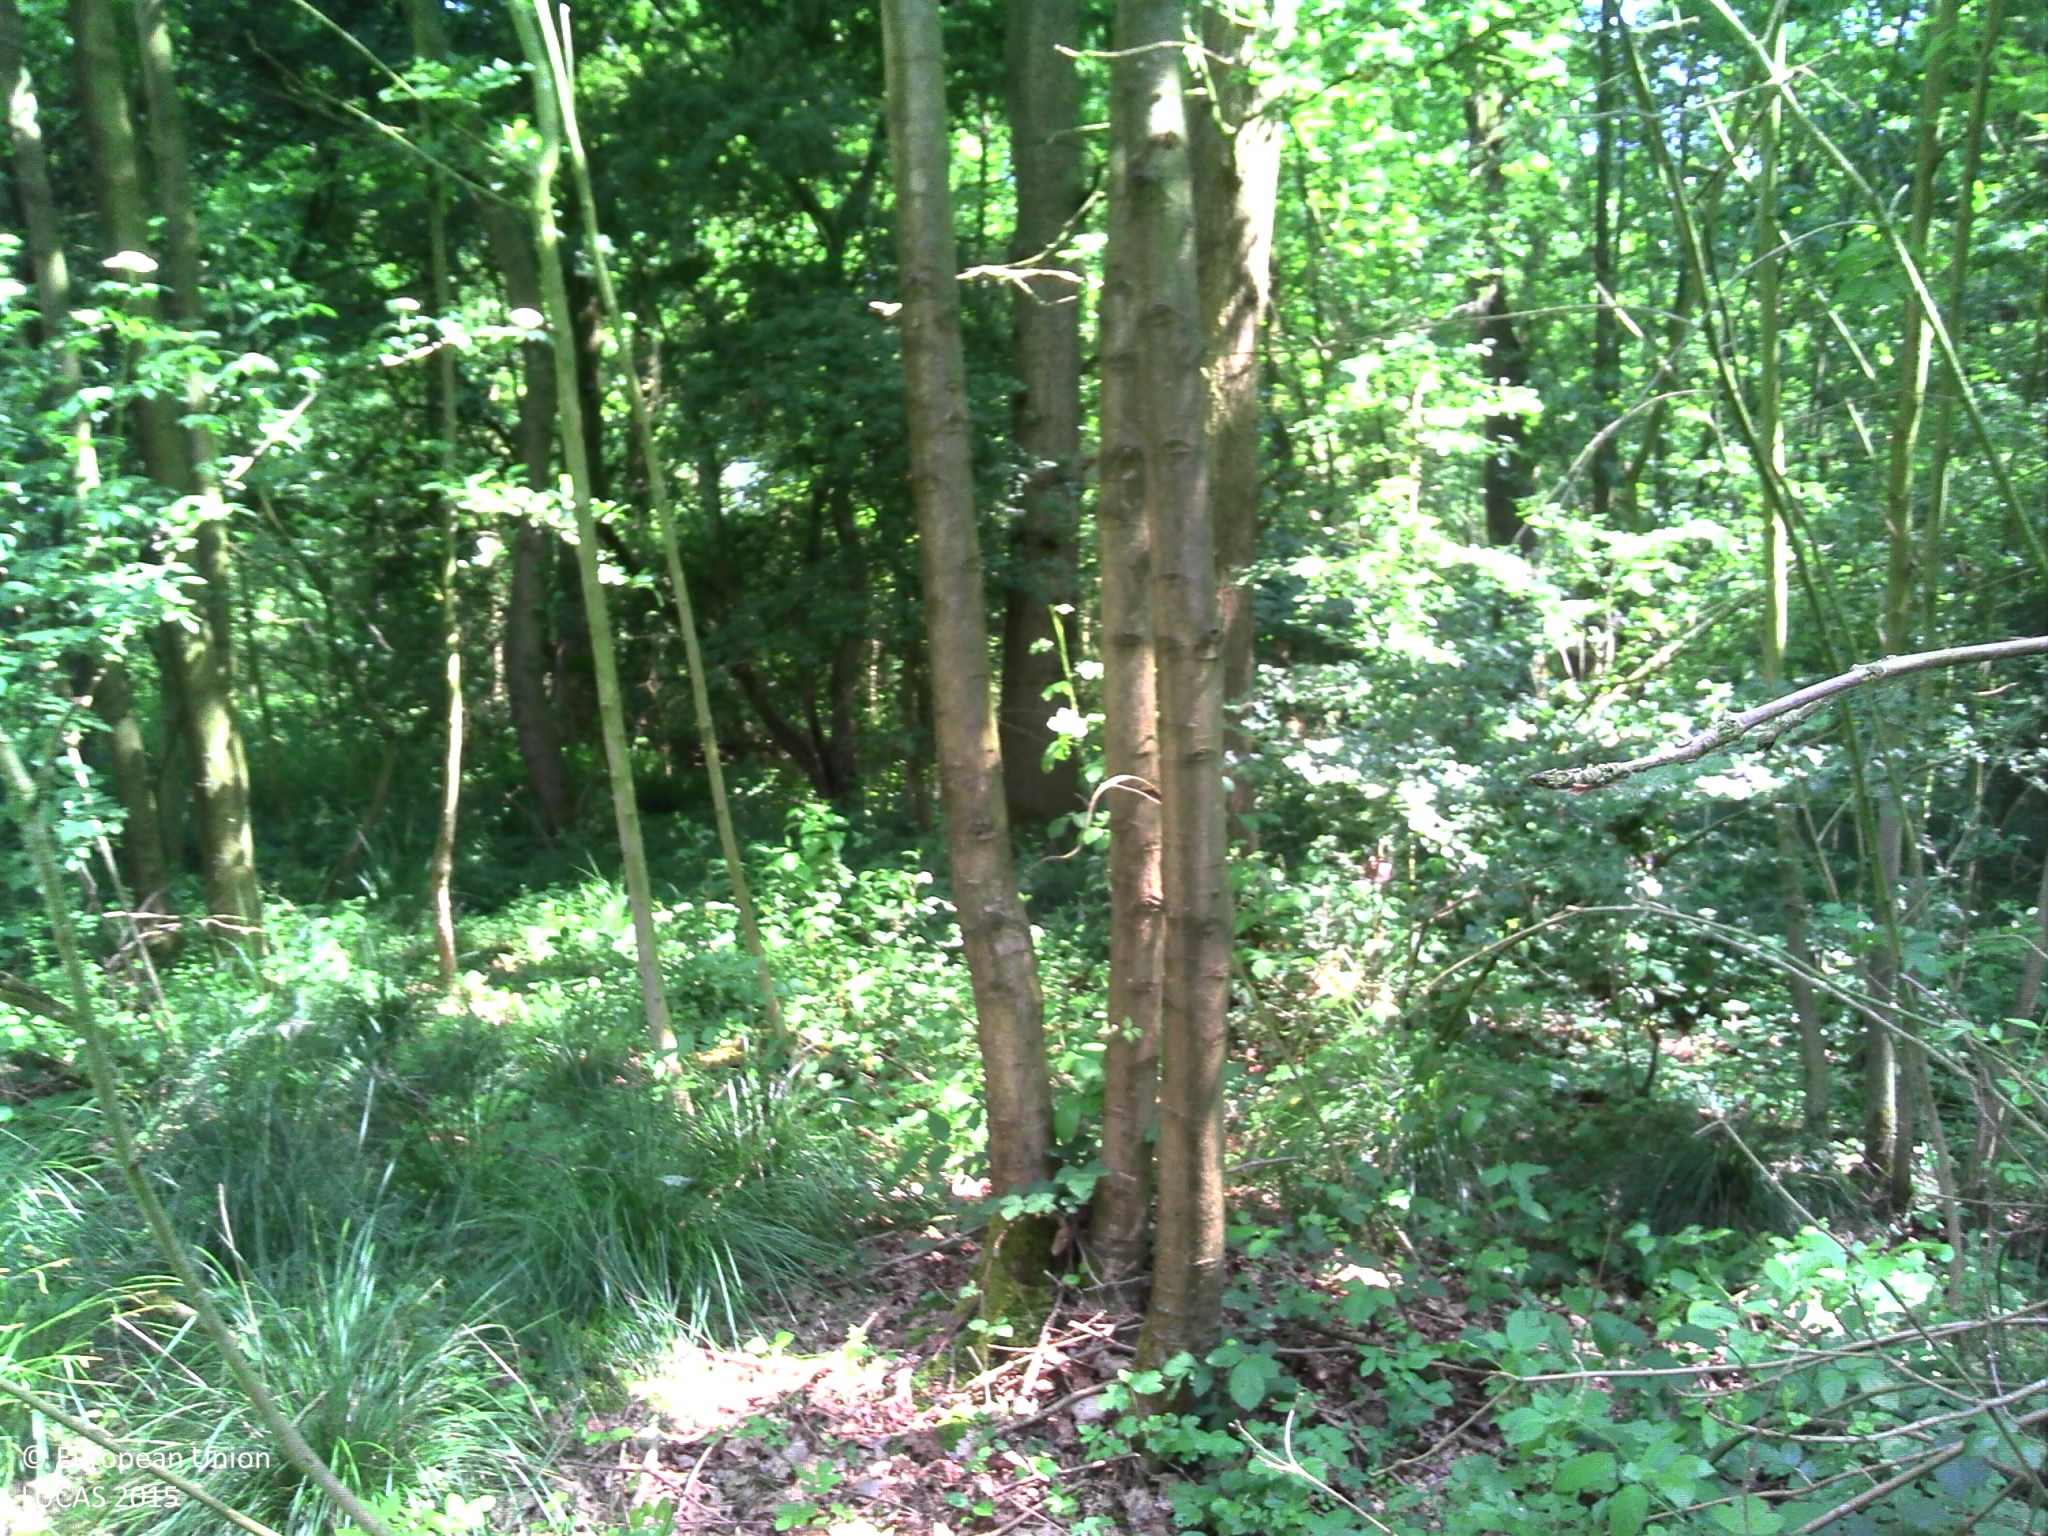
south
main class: Woodland
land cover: Broadleaved woodland
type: acidophilous oak and oak-birch forest
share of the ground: > 75 %
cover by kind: broadleaved forest trees 100 %
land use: Forestry
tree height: > 5 m
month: June
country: BE
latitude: 51.0340
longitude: 3.9619
